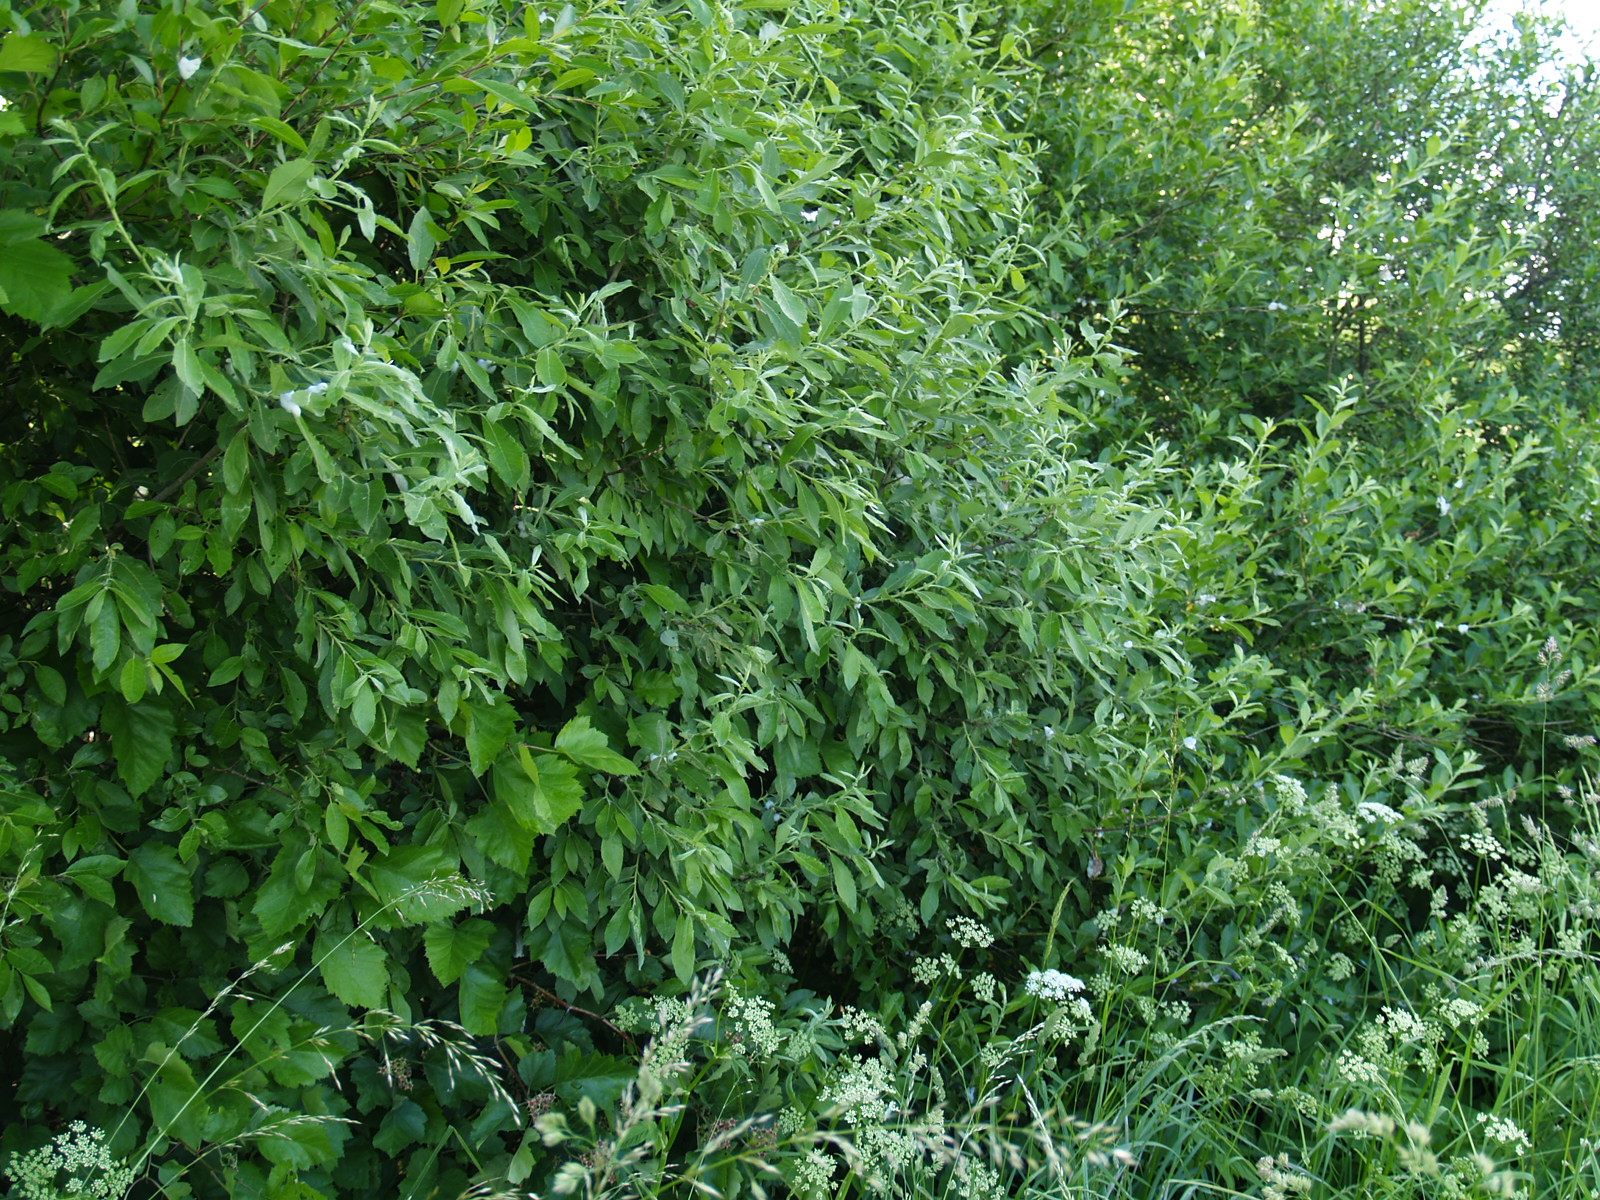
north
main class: Grassland
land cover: Grassland without tree/shrub cover
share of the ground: > 75 %
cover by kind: herbaceous plants 100 %
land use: Agriculture (excluding fallow land and kitchen gardens)
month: June
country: LV
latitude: 56.6139
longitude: 25.6520
